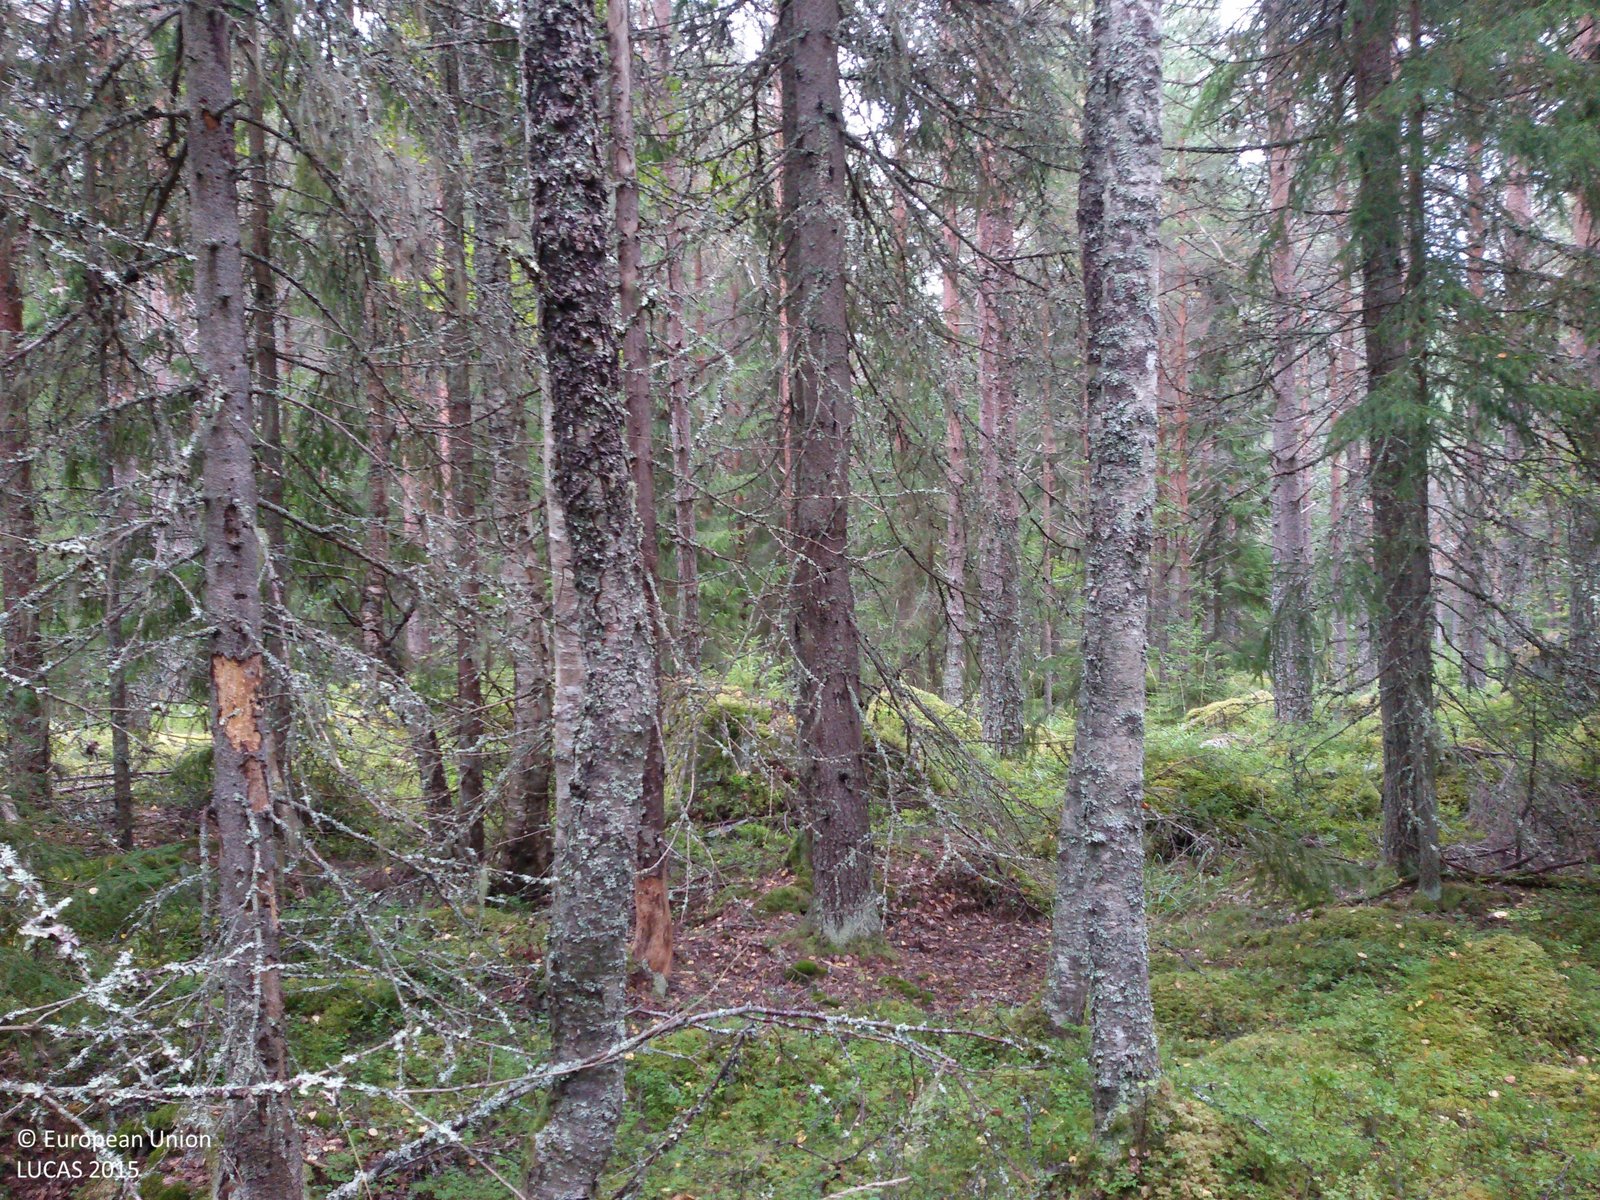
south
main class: Woodland
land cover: Spruce dominated coniferous woodland
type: boreal forest
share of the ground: > 75 %
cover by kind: coniferous forest trees 75 %, lichens and mosses 15 %, shrubs 10 %
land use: Forestry
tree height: > 5 m
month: September
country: SE
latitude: 60.7839
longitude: 15.3313
